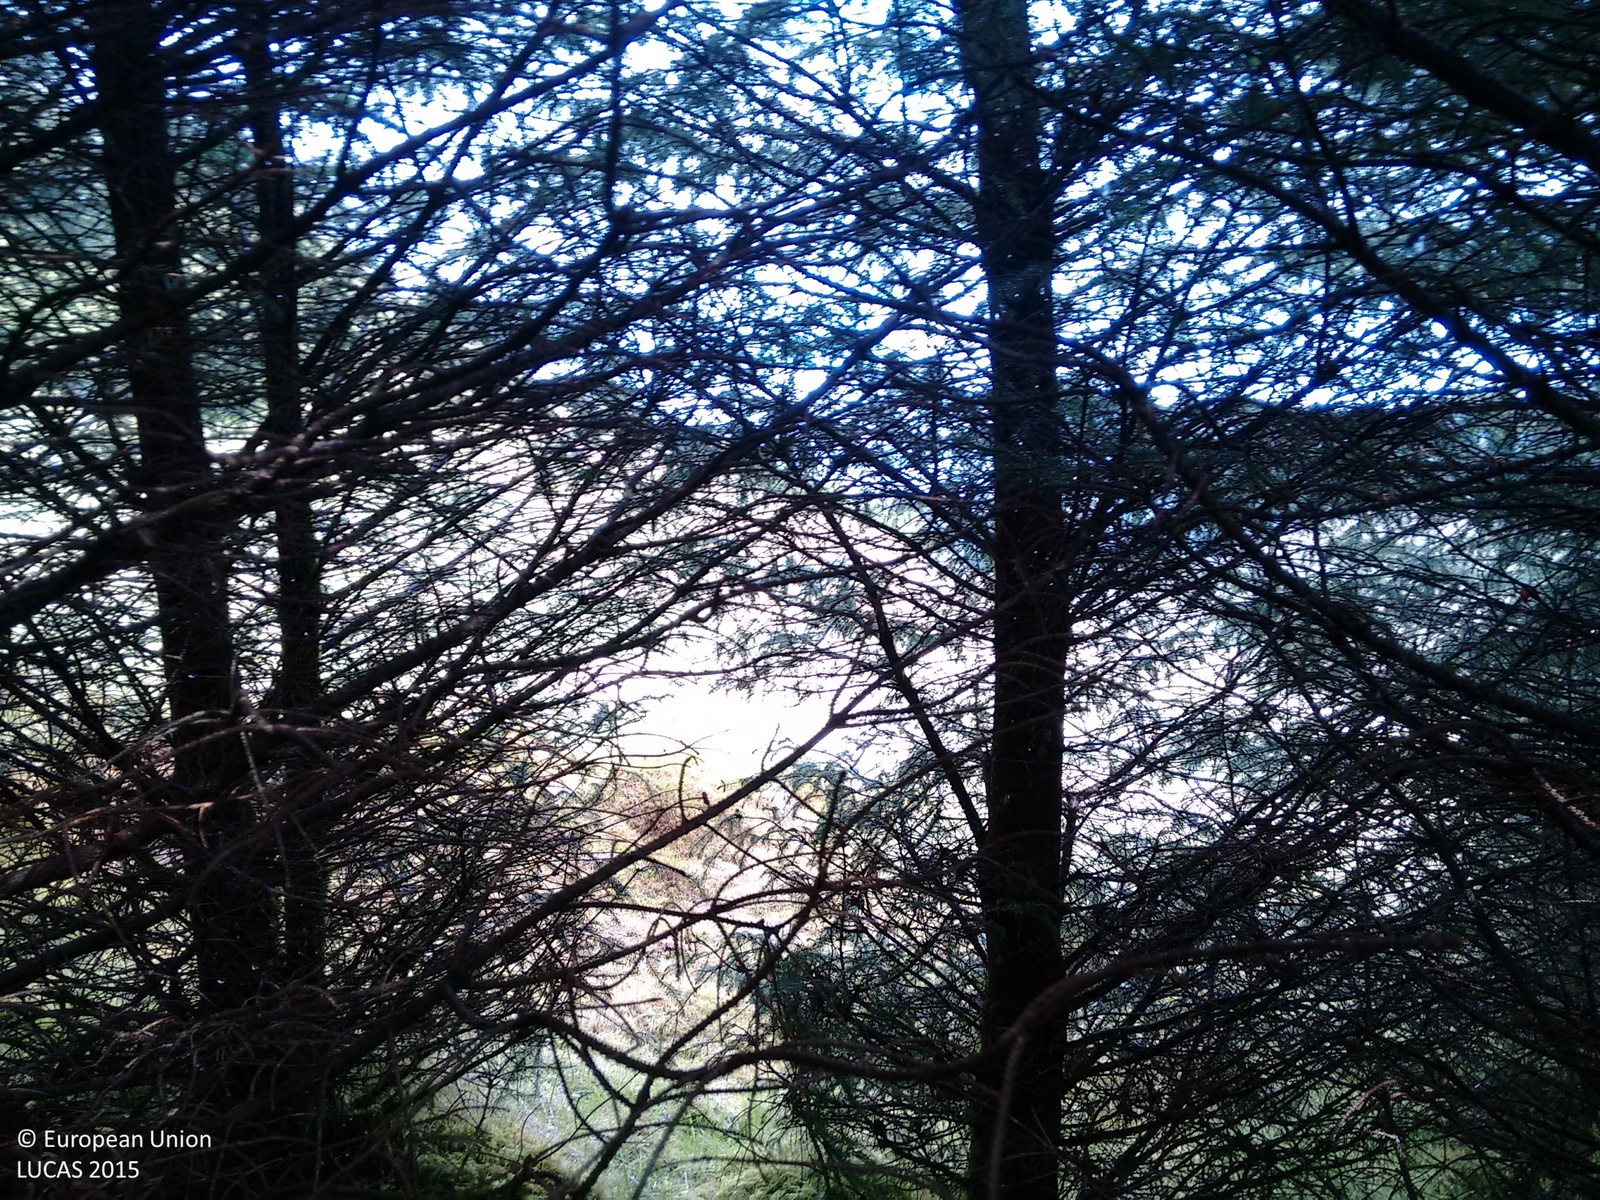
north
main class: Woodland
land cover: Spruce dominated coniferous woodland
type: exotic forest
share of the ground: > 75 %
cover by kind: coniferous forest trees 100 %
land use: Forestry
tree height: > 5 m
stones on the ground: < 10 %
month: May
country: GB
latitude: 56.1098
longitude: -5.1152
